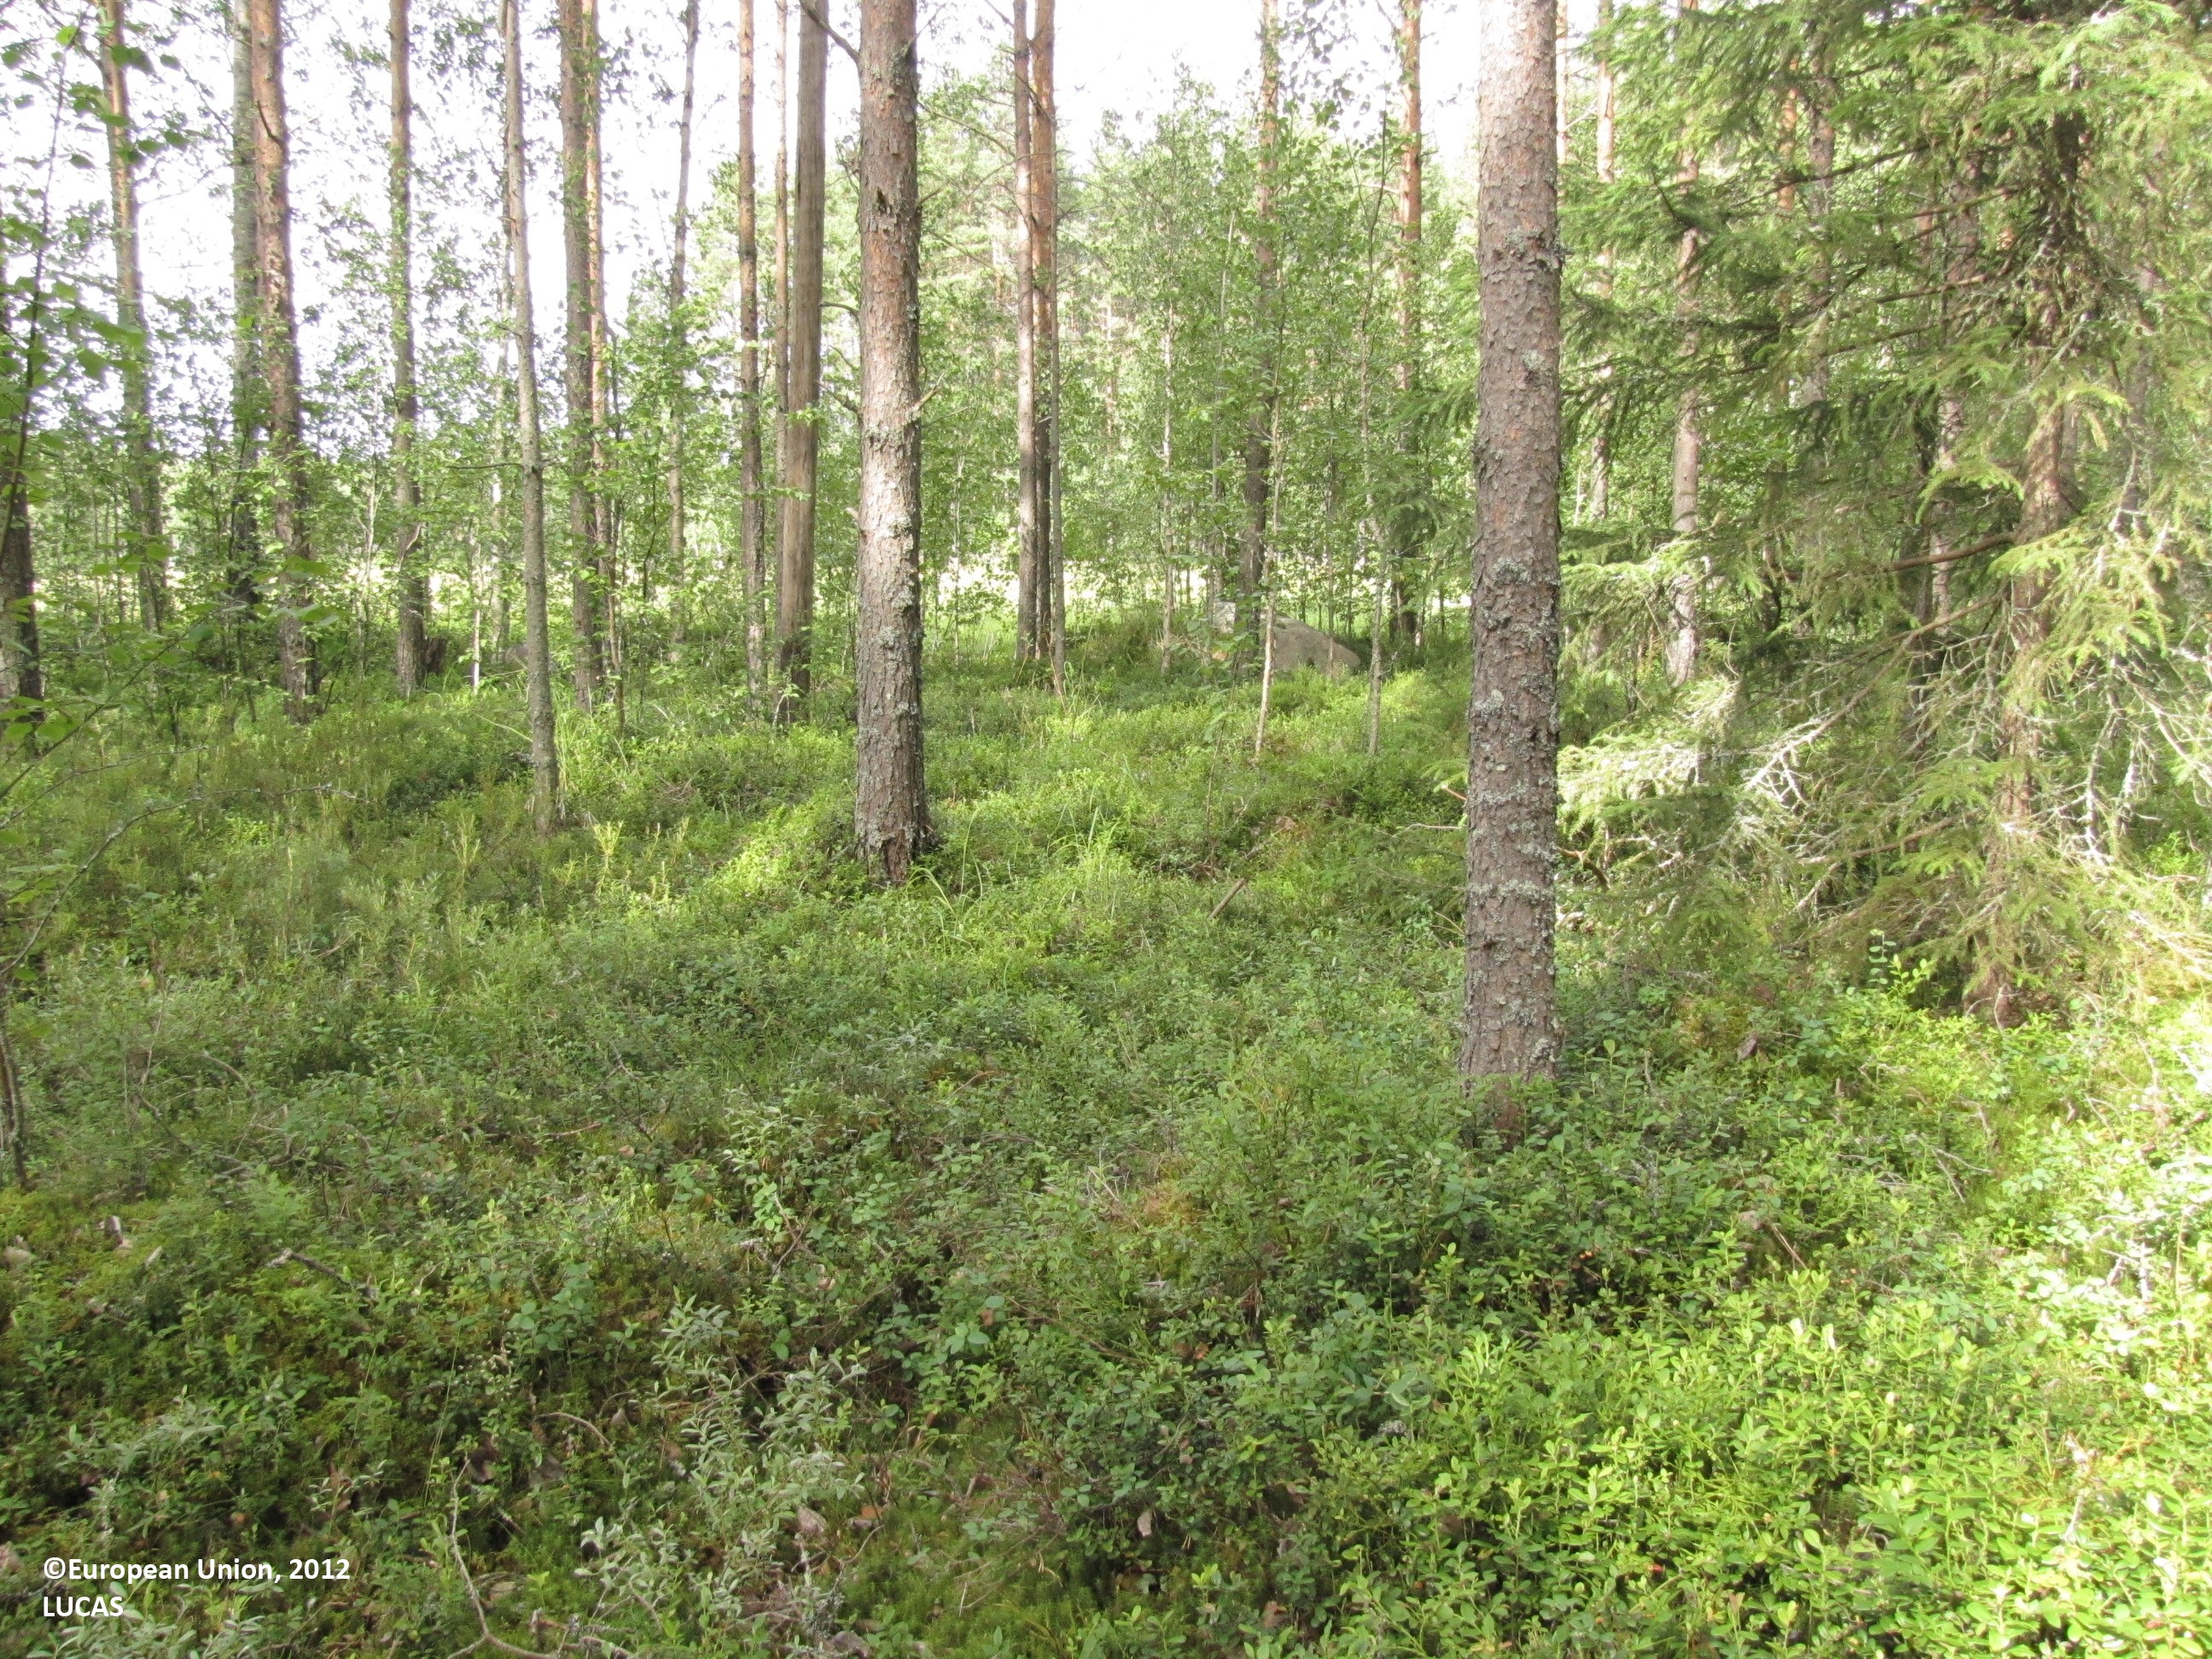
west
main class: Woodland
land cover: Pine dominated coniferous woodland
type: boreal forest
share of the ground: > 75 %
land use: Forestry
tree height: > 5 m
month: July
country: FI
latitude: 62.3171
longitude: 23.2466
